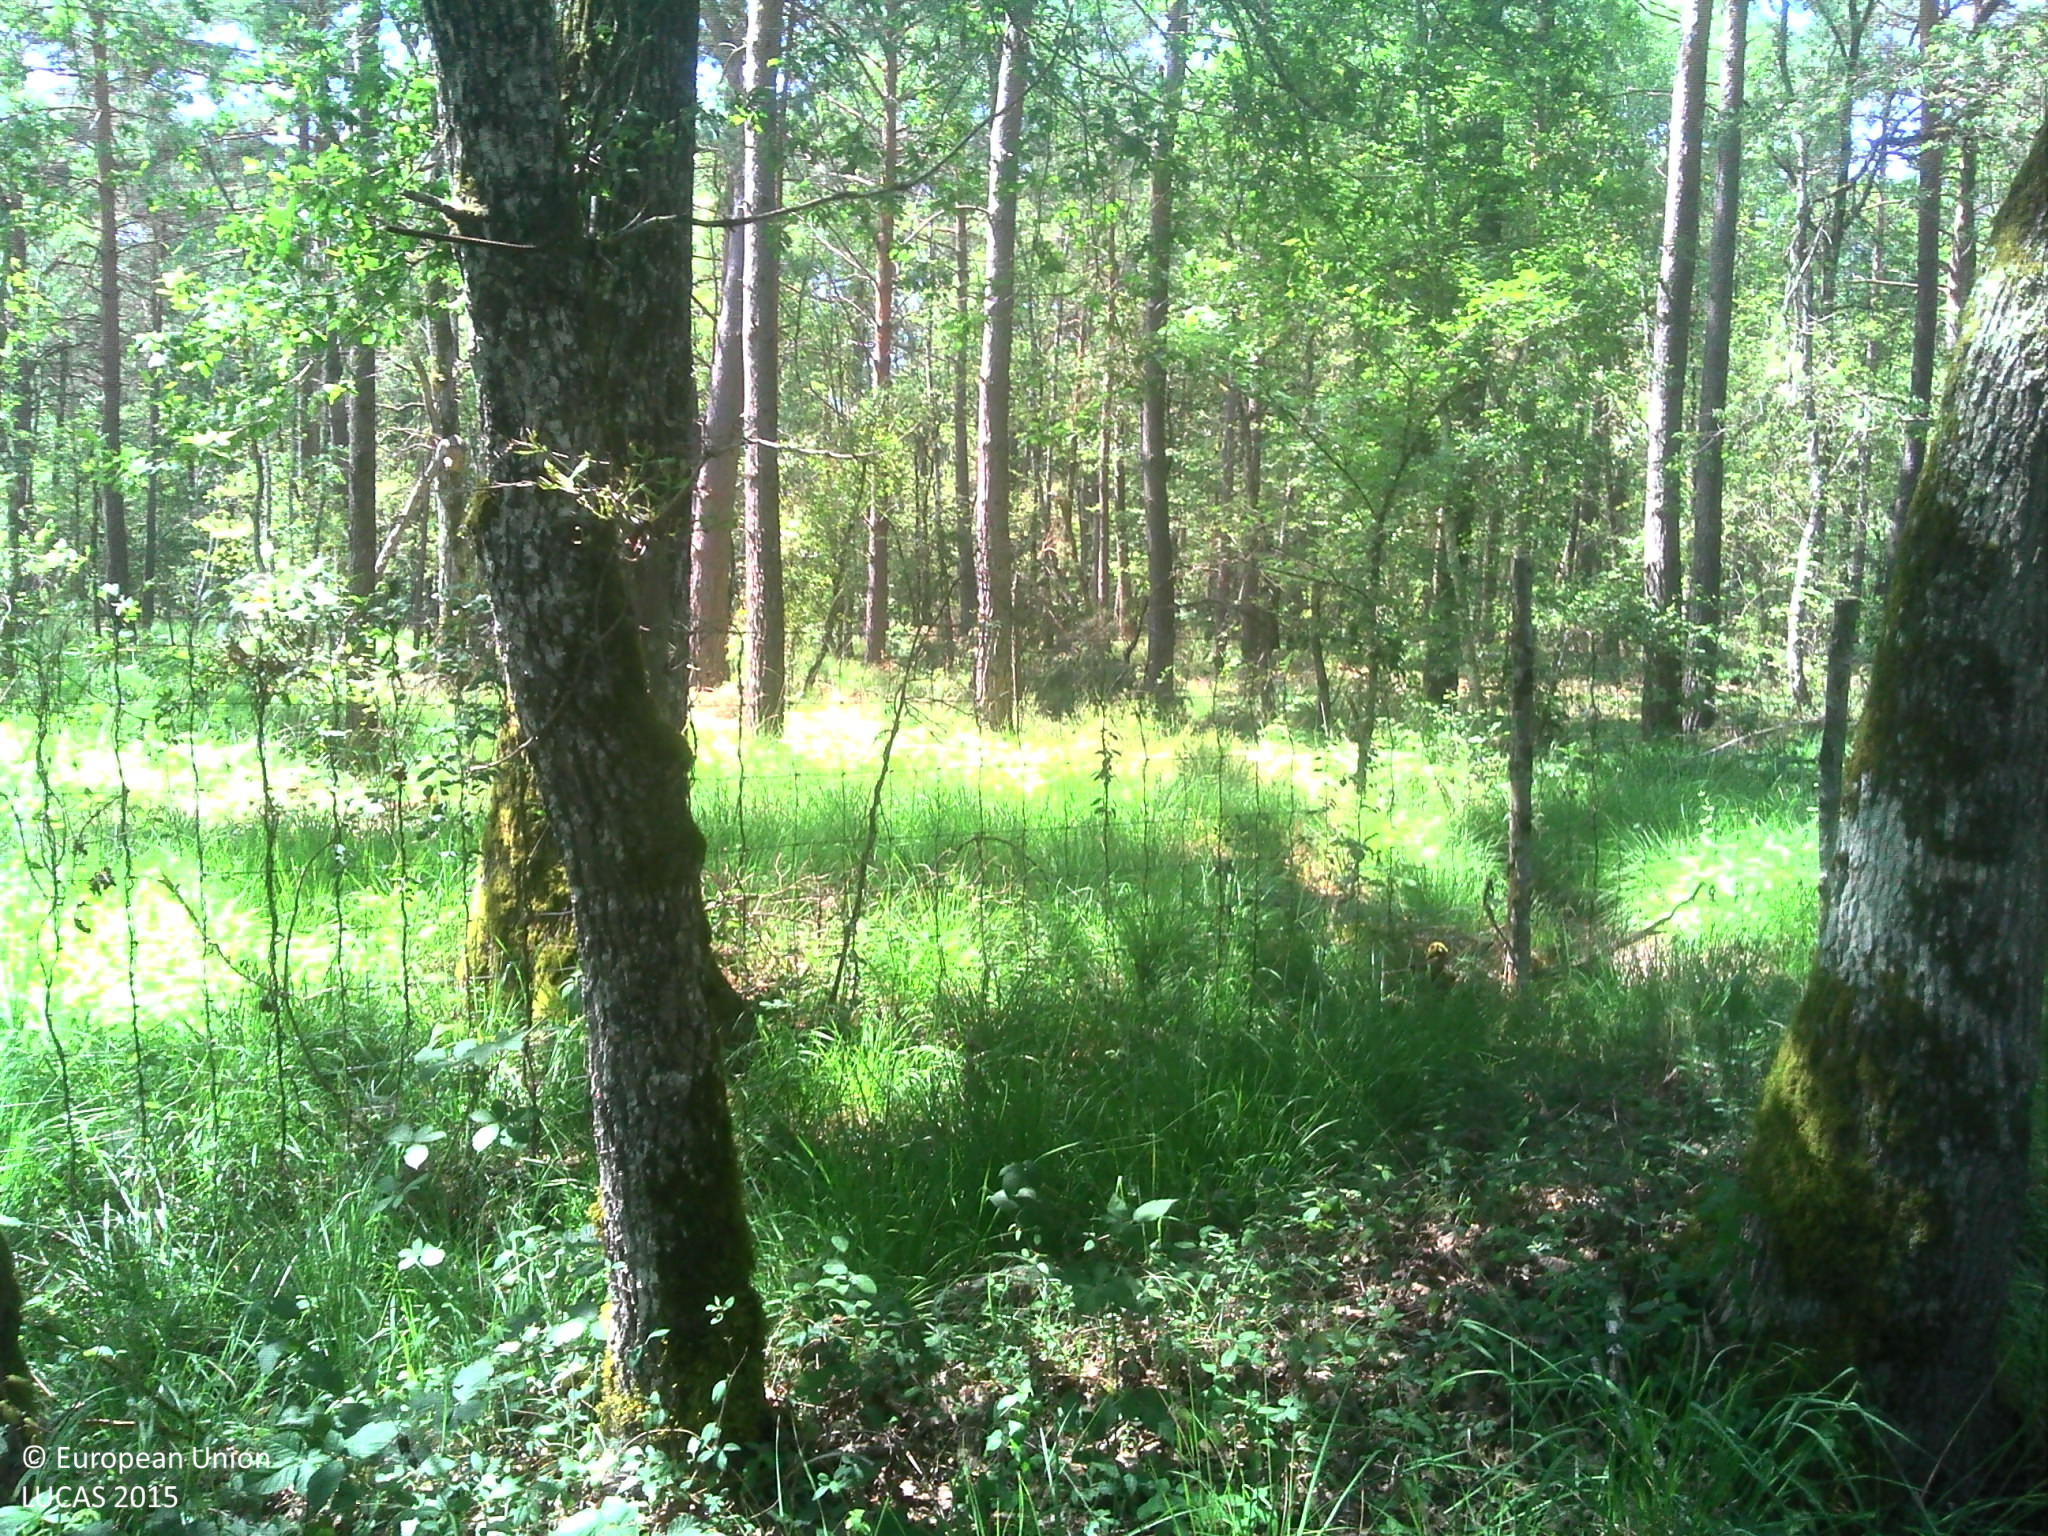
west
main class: Woodland
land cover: Pine dominated mixed woodland
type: thermophilous deciduous forest
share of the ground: > 75 %
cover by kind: herbaceous plants 50 %, unconsolidated bare surface 30 %, coniferous forest trees 10 %, broadleaved forest trees 10 %
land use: Forestry
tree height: > 5 m
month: June
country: FR
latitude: 47.4414
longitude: 1.4863
